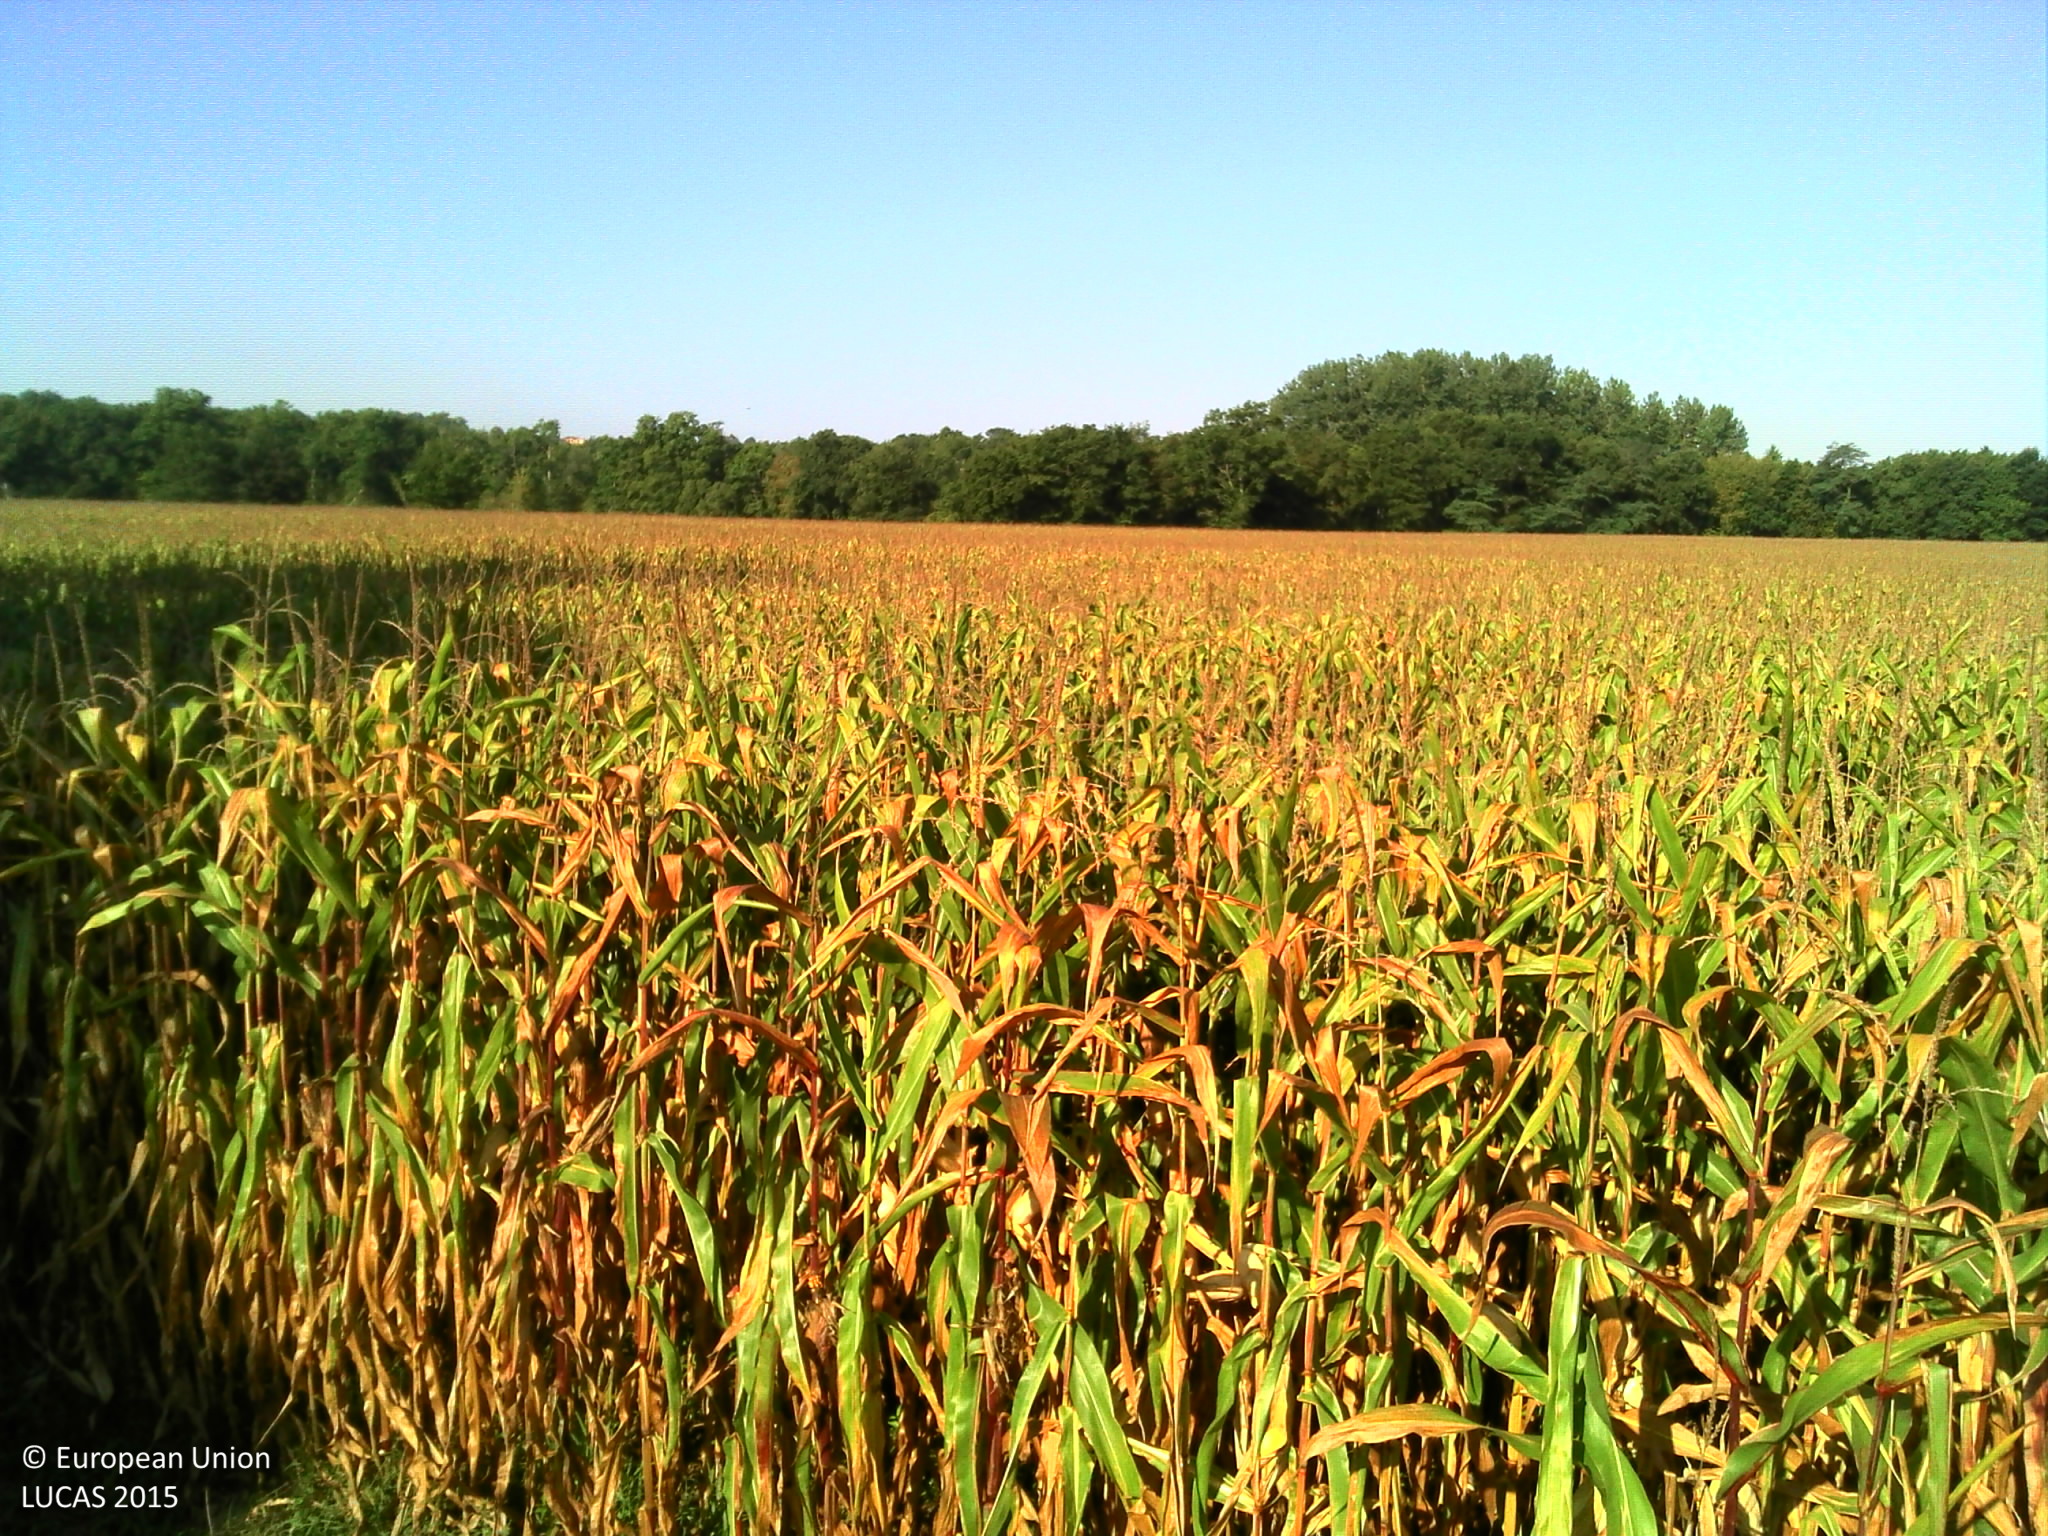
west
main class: Cropland
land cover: Maize
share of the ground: > 75 %
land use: Agriculture (excluding fallow land and kitchen gardens)
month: September
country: FR
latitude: 43.5547
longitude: -0.7440
